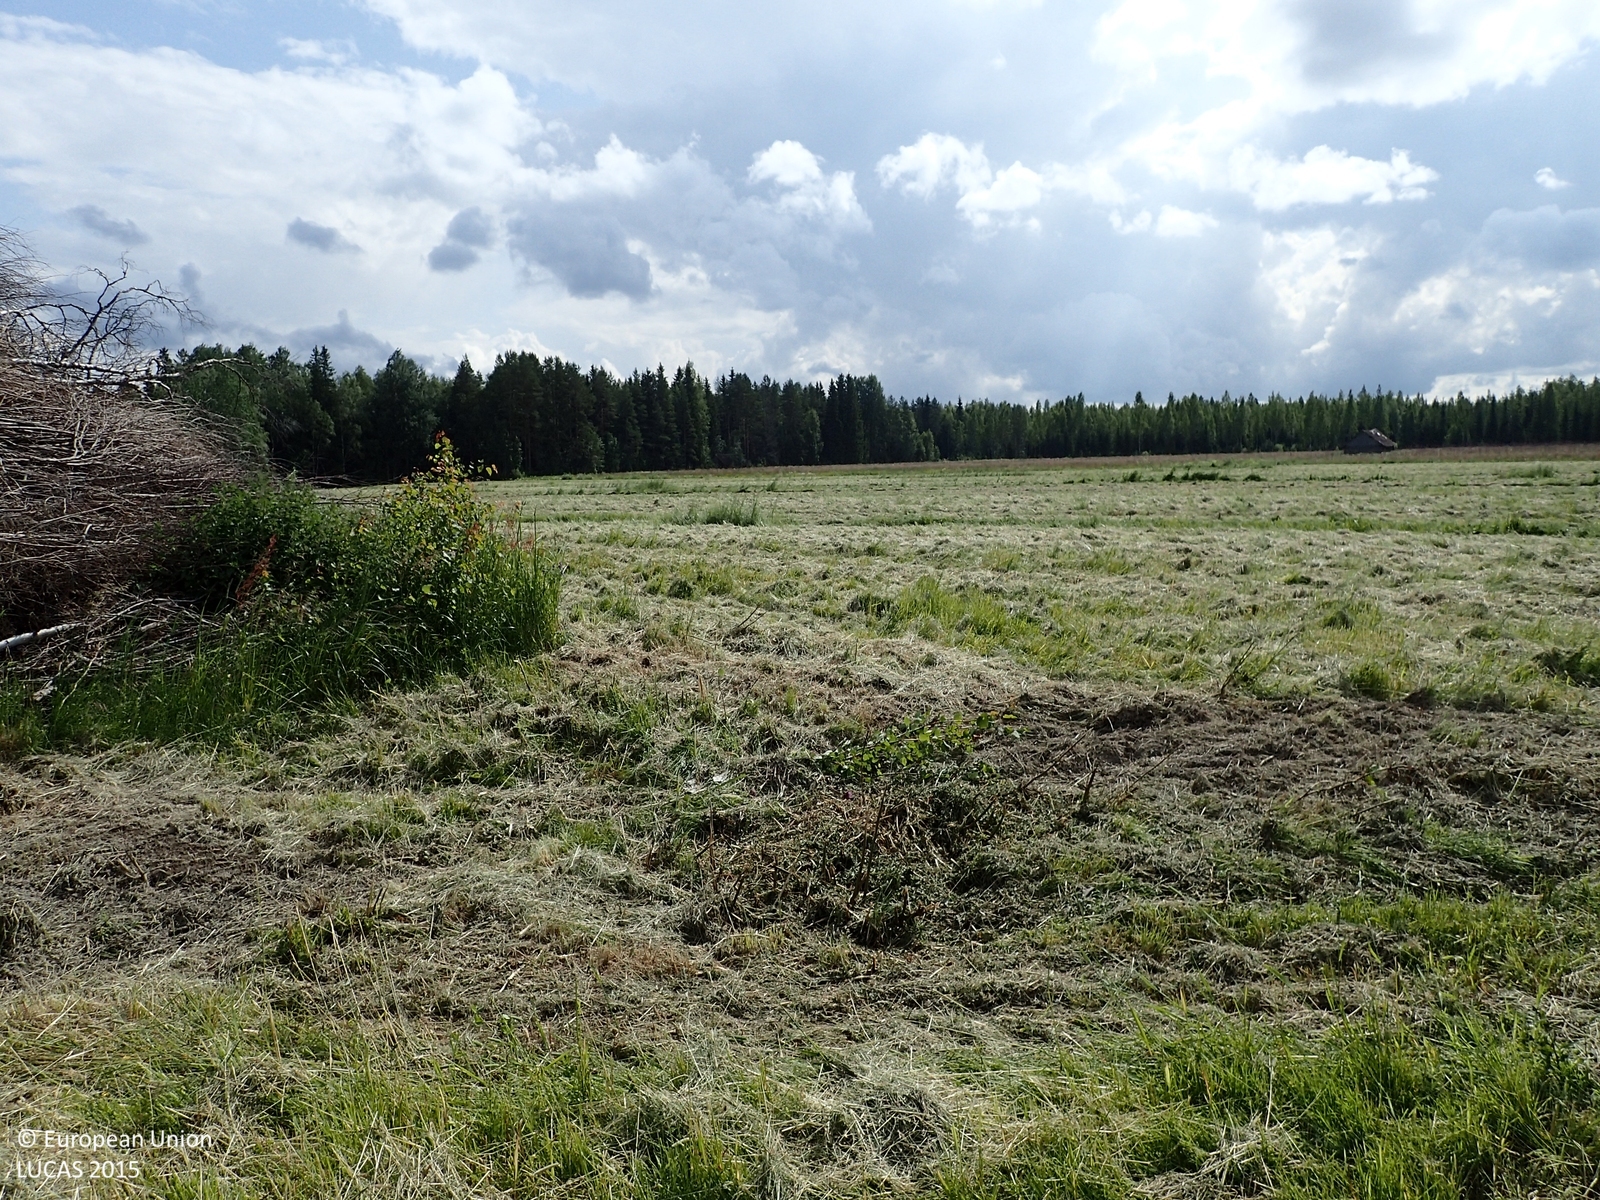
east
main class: Cropland
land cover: Temporary grasslands
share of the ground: > 75 %
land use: Agriculture (excluding fallow land and kitchen gardens)
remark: Harvested field
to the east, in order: Temporary grasslands; Ditches and canals; Temporary grasslands; Ditches and canals; Temporary grasslands; Ditches and canals; Temporary grasslands; Ditches and canals; Temporary grasslands; Ditches and canals; Temporary grasslands; Ditches and canals; Temporary grasslands; Ditches and canals; Temporary grasslands; Ditches and canals; Temporary grasslands
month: July
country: FI
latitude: 62.7585
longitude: 23.6416
